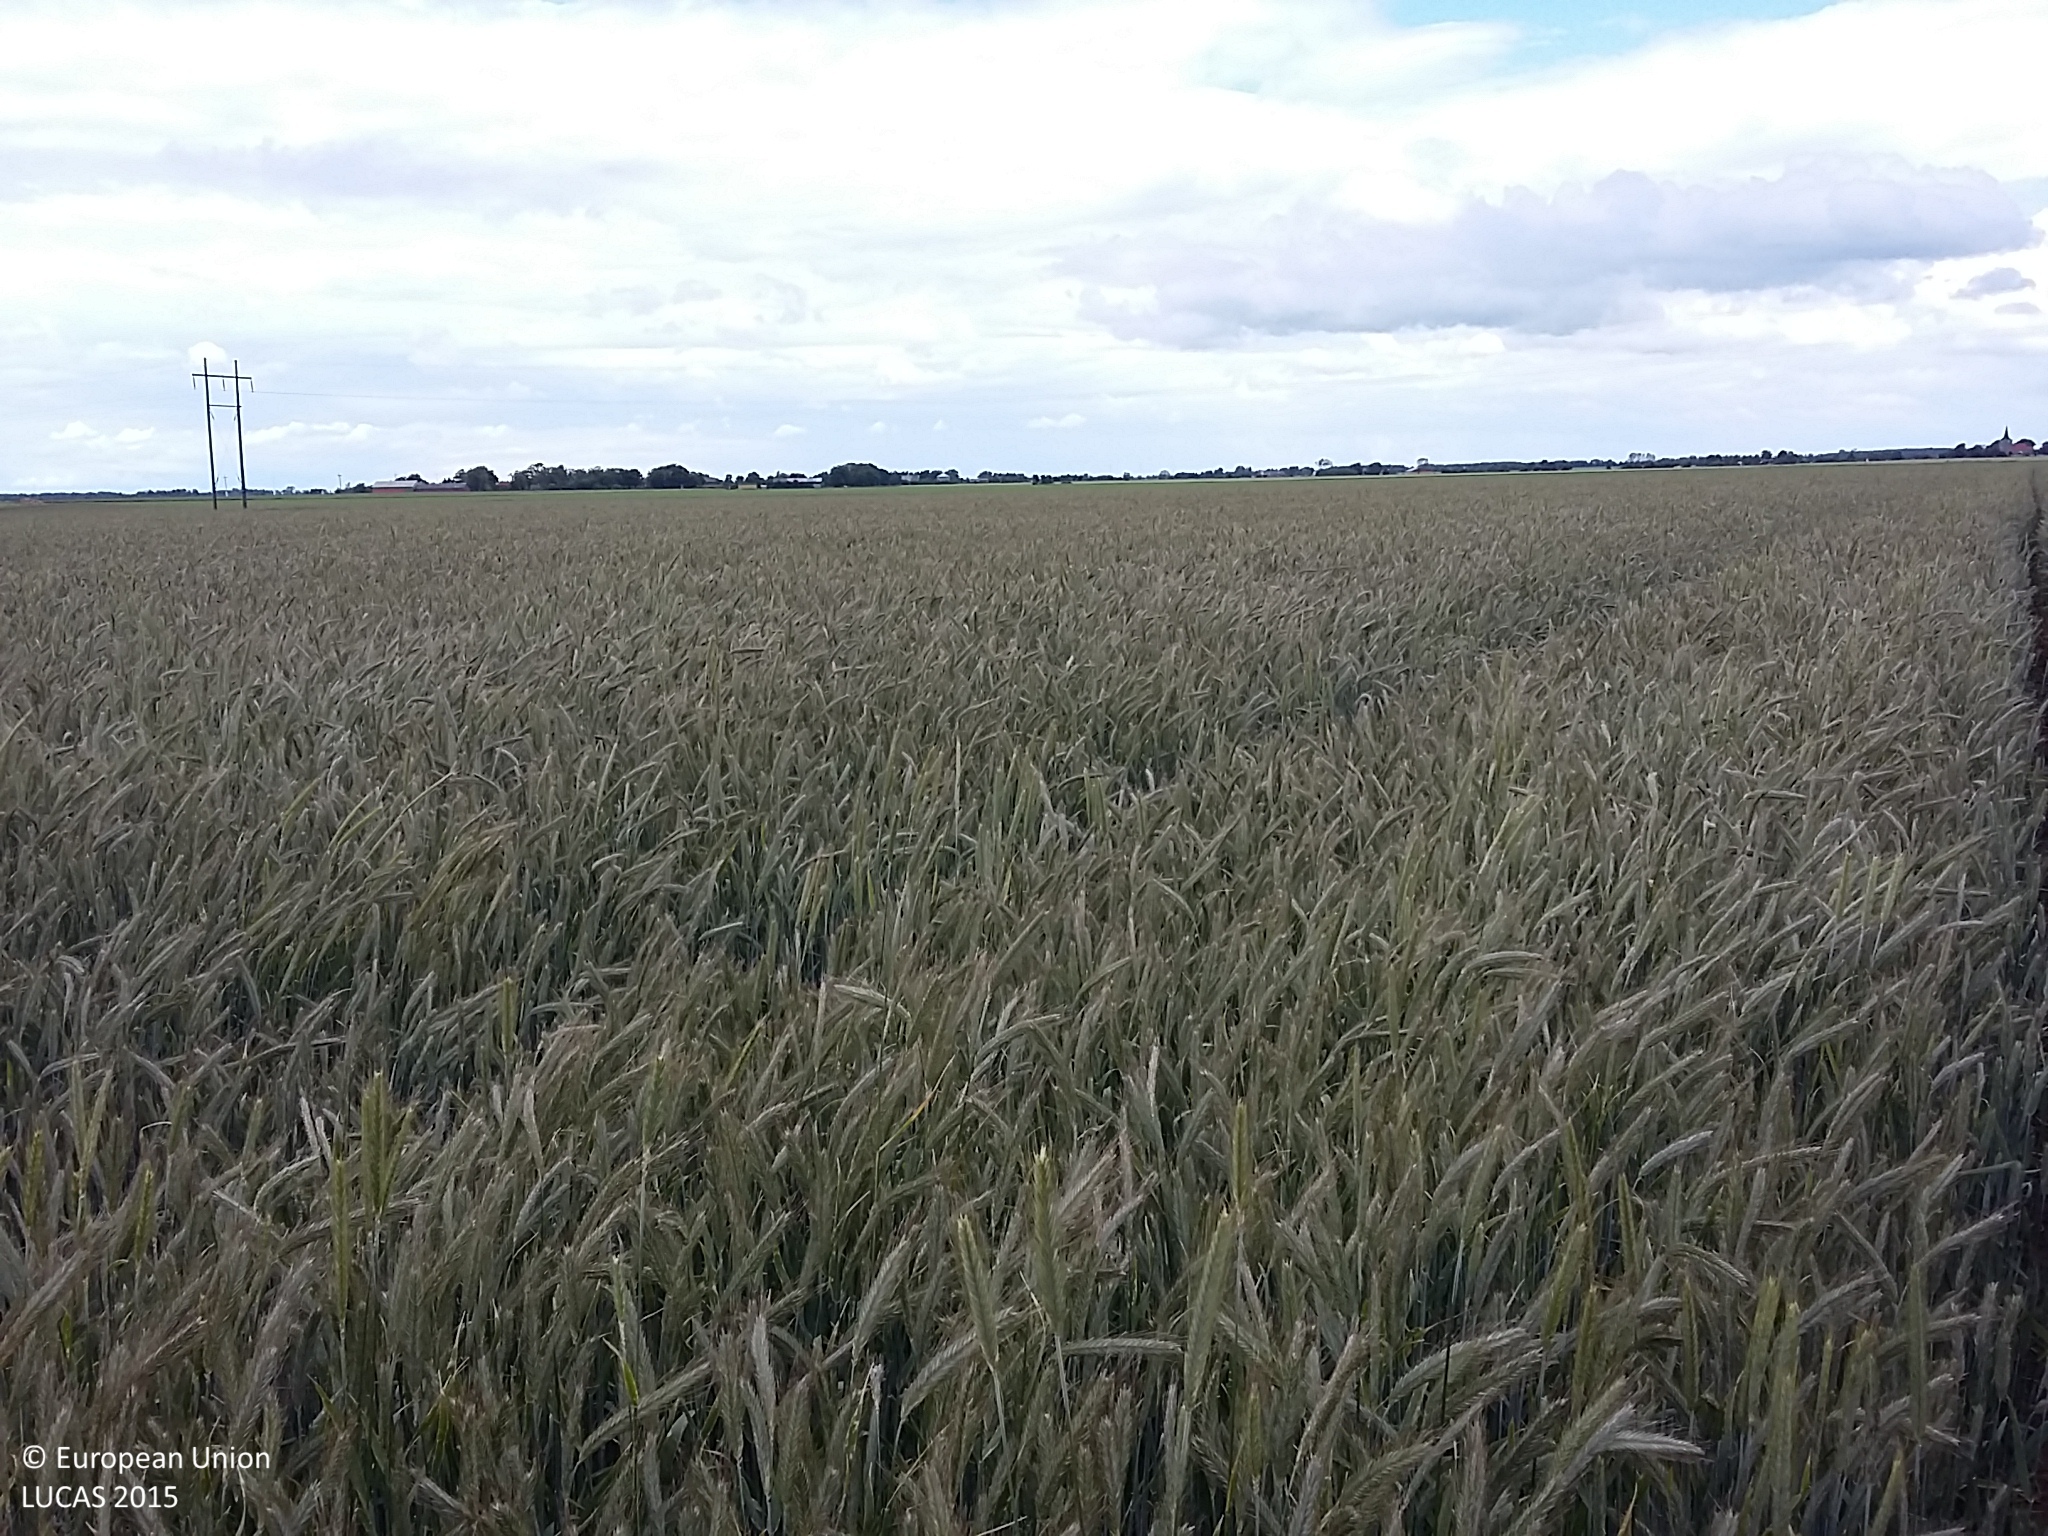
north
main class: Cropland
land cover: Rye
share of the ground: > 75 %
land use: Agriculture (excluding fallow land and kitchen gardens)
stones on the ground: < 10 %
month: June
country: DK
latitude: 54.7435
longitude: 11.2574
